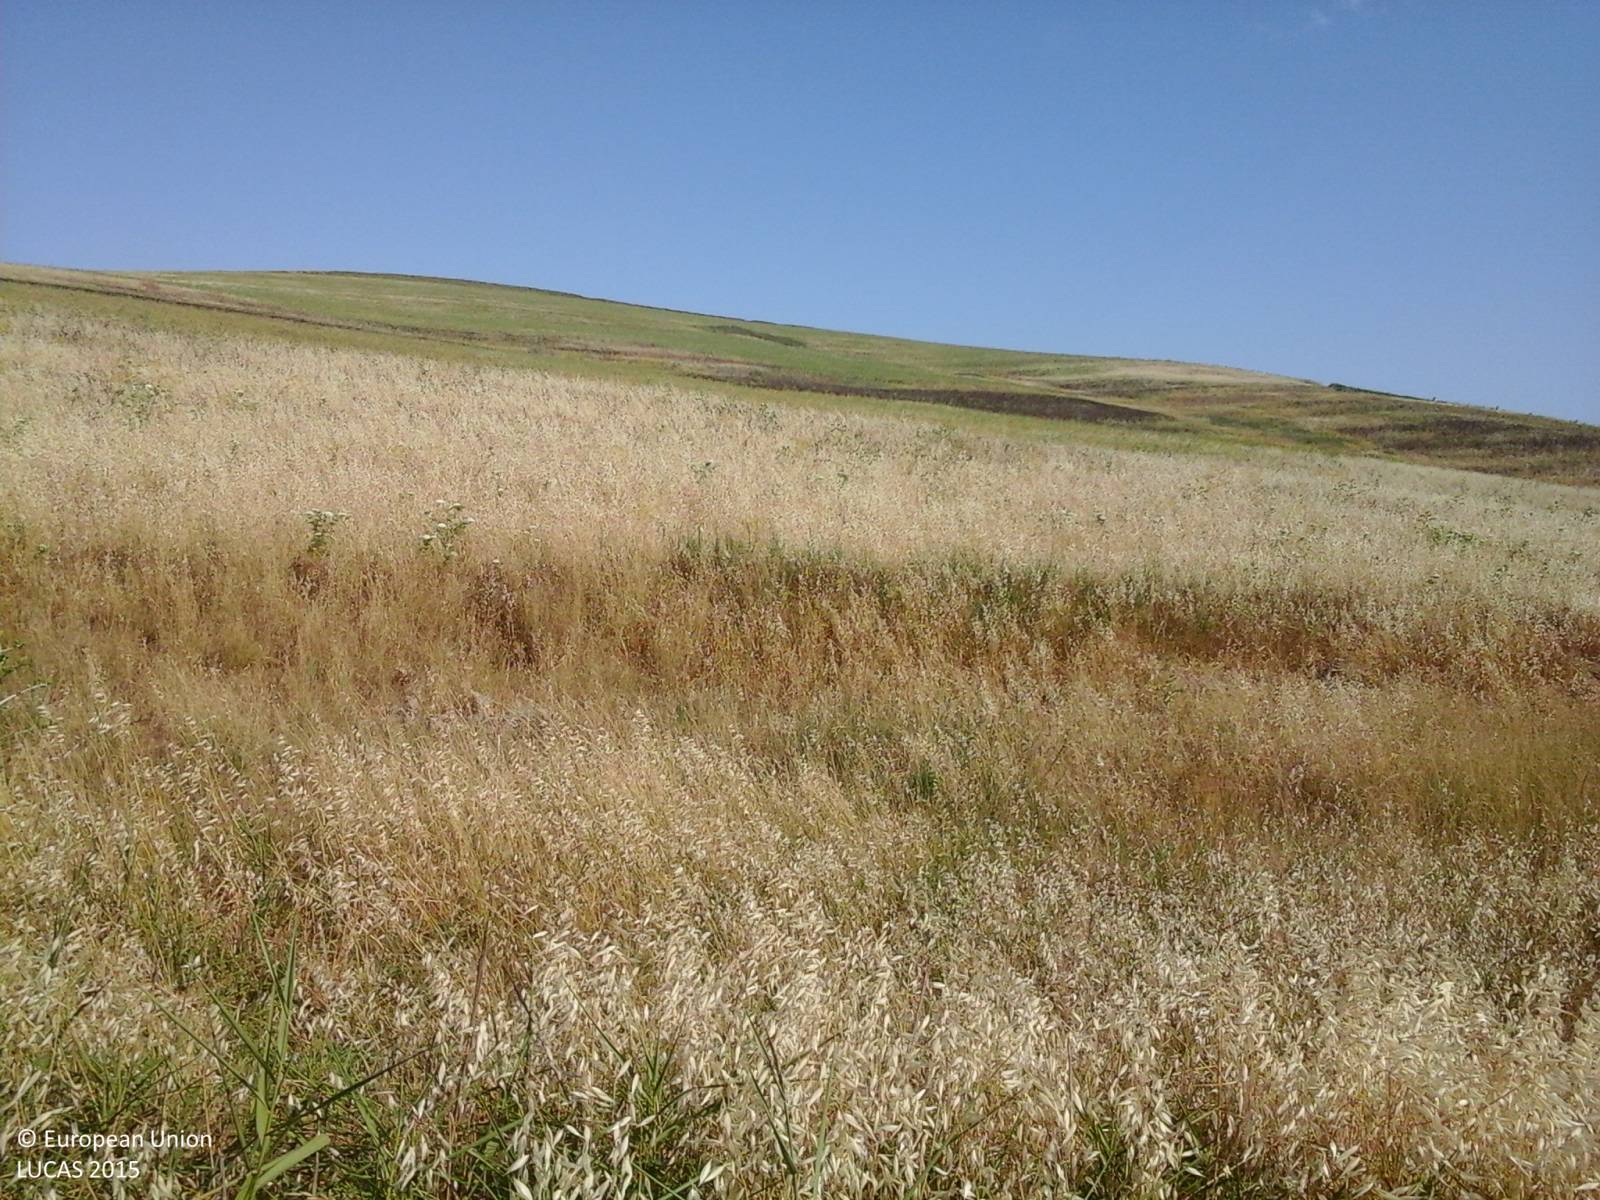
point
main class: Cropland
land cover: Other leguminous and mixtures for fodder
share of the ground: > 75 %
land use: Agriculture (excluding fallow land and kitchen gardens)
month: June
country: IT
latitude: 37.8909
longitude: 12.6979
